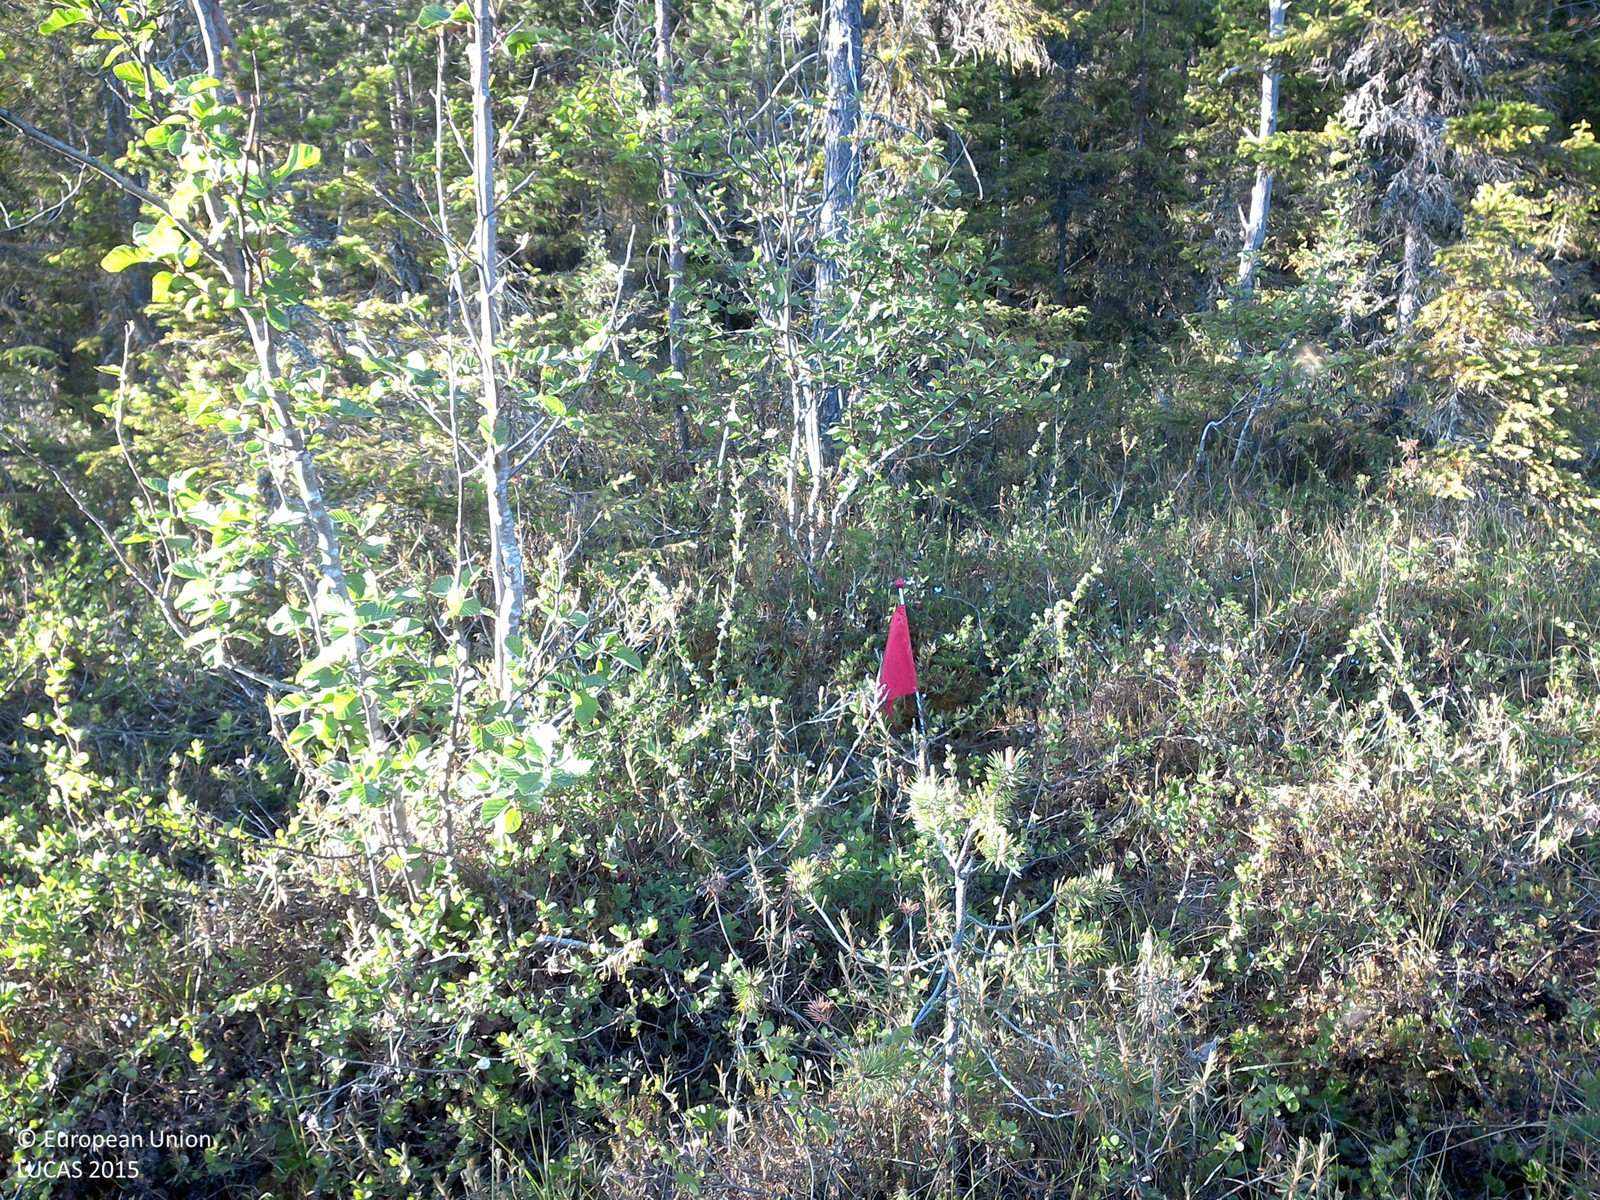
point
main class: Woodland
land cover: Pine dominated coniferous woodland
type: boreal forest
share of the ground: 10 - 25 %
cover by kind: shrubs 70 %, coniferous forest trees 20 %, herbaceous plants 10 %
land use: Semi-natural and natural areas not in use
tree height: > 5 m
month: June
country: SE
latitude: 66.6806
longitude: 22.9001
